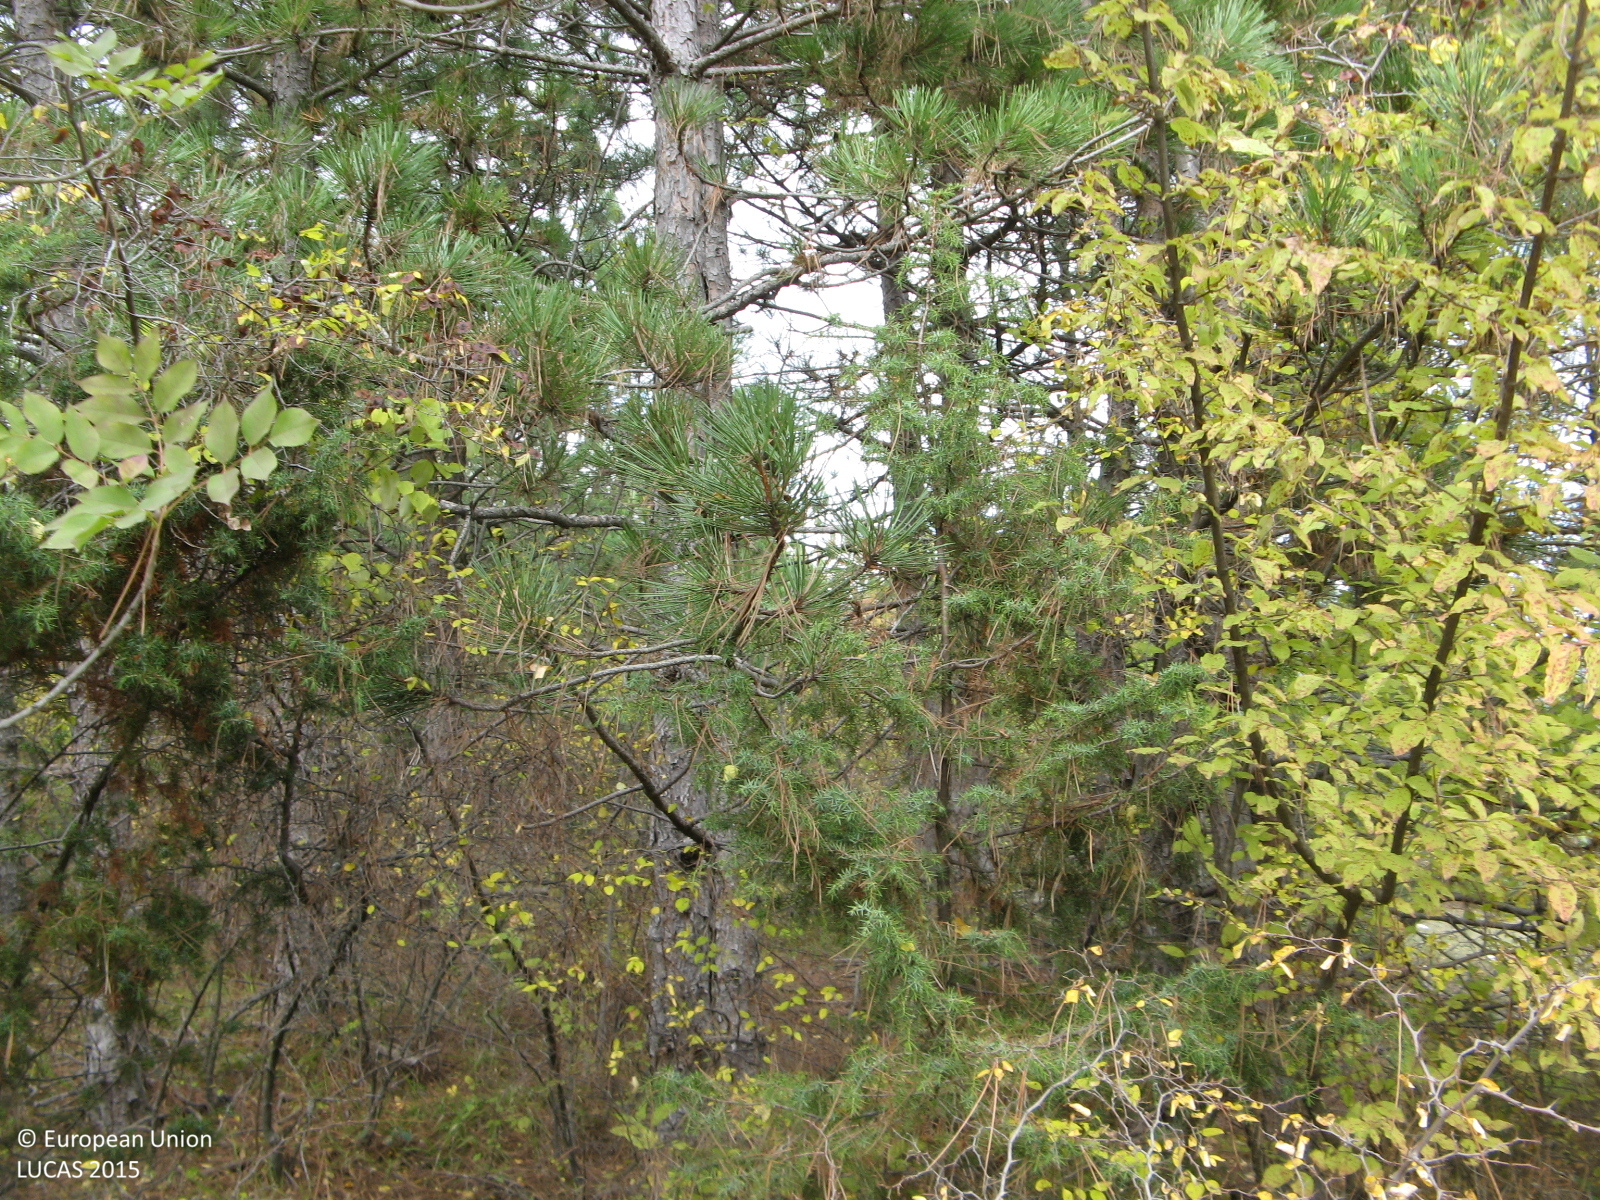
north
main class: Woodland
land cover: Pine dominated mixed woodland
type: hemiboreal forest and nemoral coniferous forest and mixed broadleaved-coniferous forest
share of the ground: > 75 %
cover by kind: coniferous forest trees 75 %, broadleaved forest trees 25 %
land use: Forestry
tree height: > 5 m
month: November
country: BG
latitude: 41.4697
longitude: 25.2716
